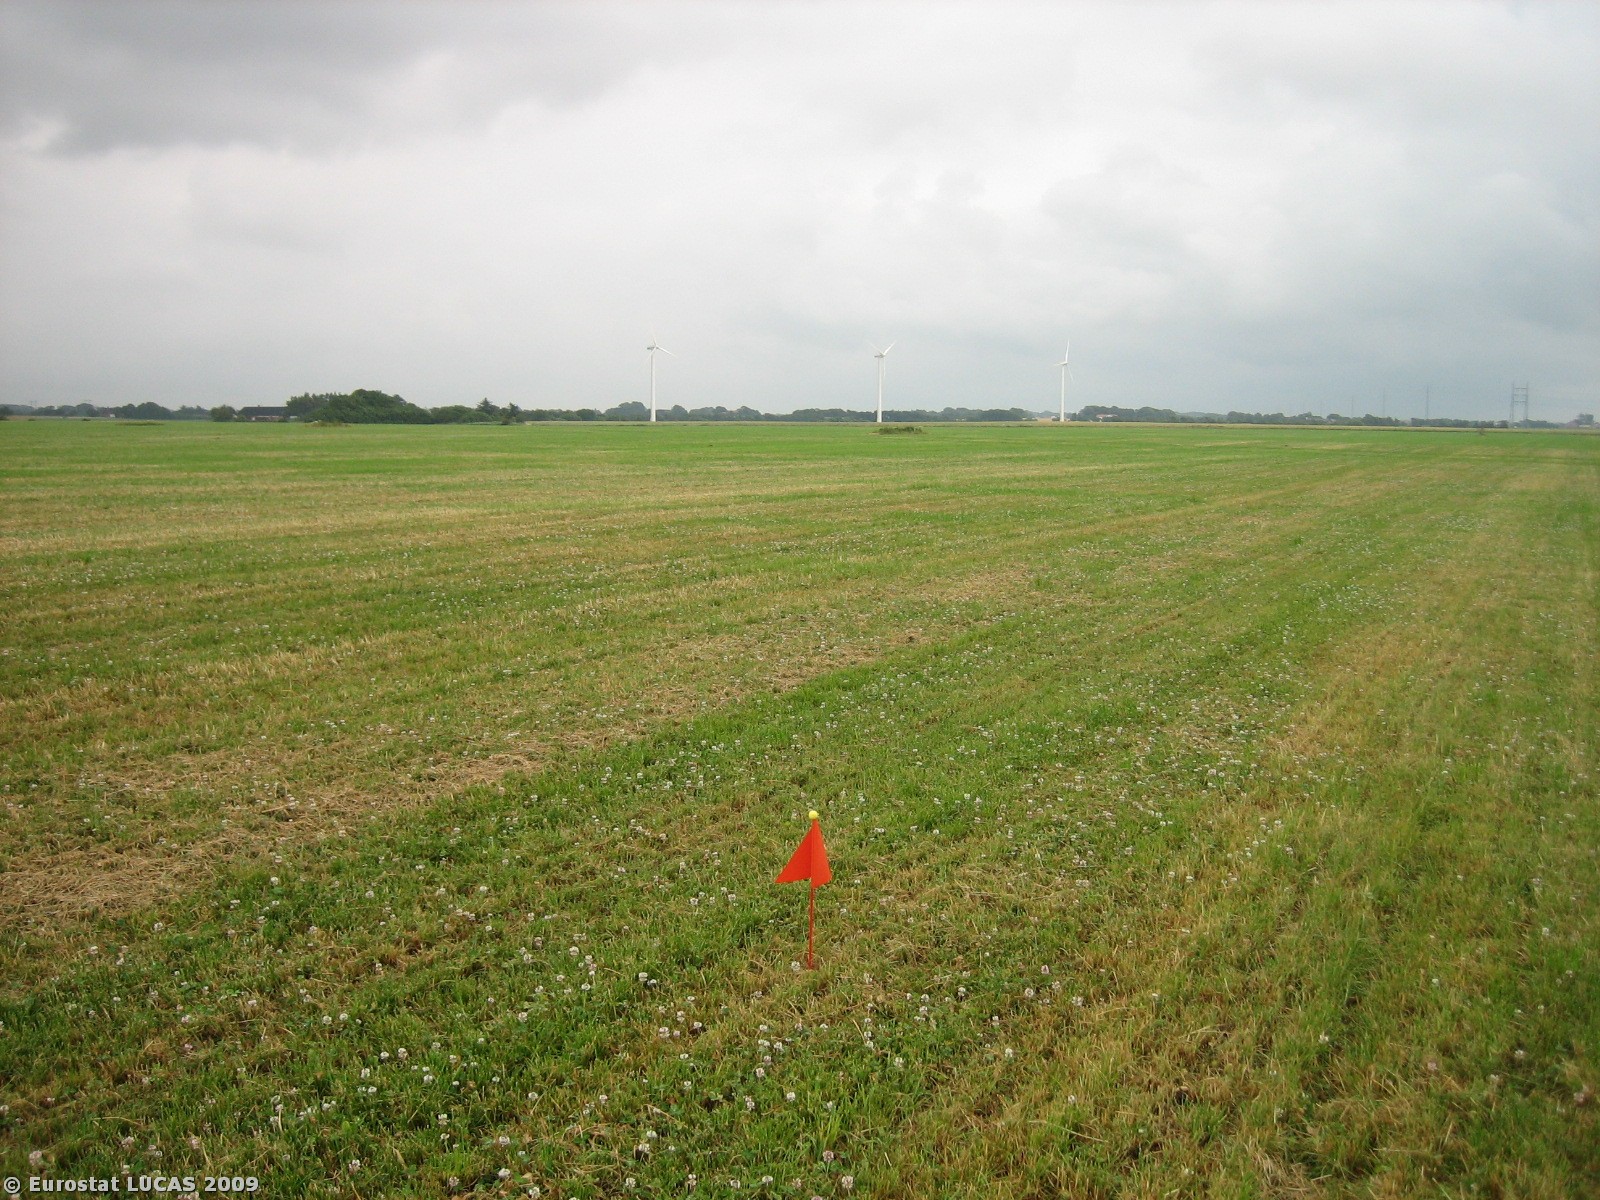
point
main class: Cropland
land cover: Temporary grasslands
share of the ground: > 75 %
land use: Agriculture (excluding fallow land and kitchen gardens)
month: July
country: DK
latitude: 55.4437
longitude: 8.6575
